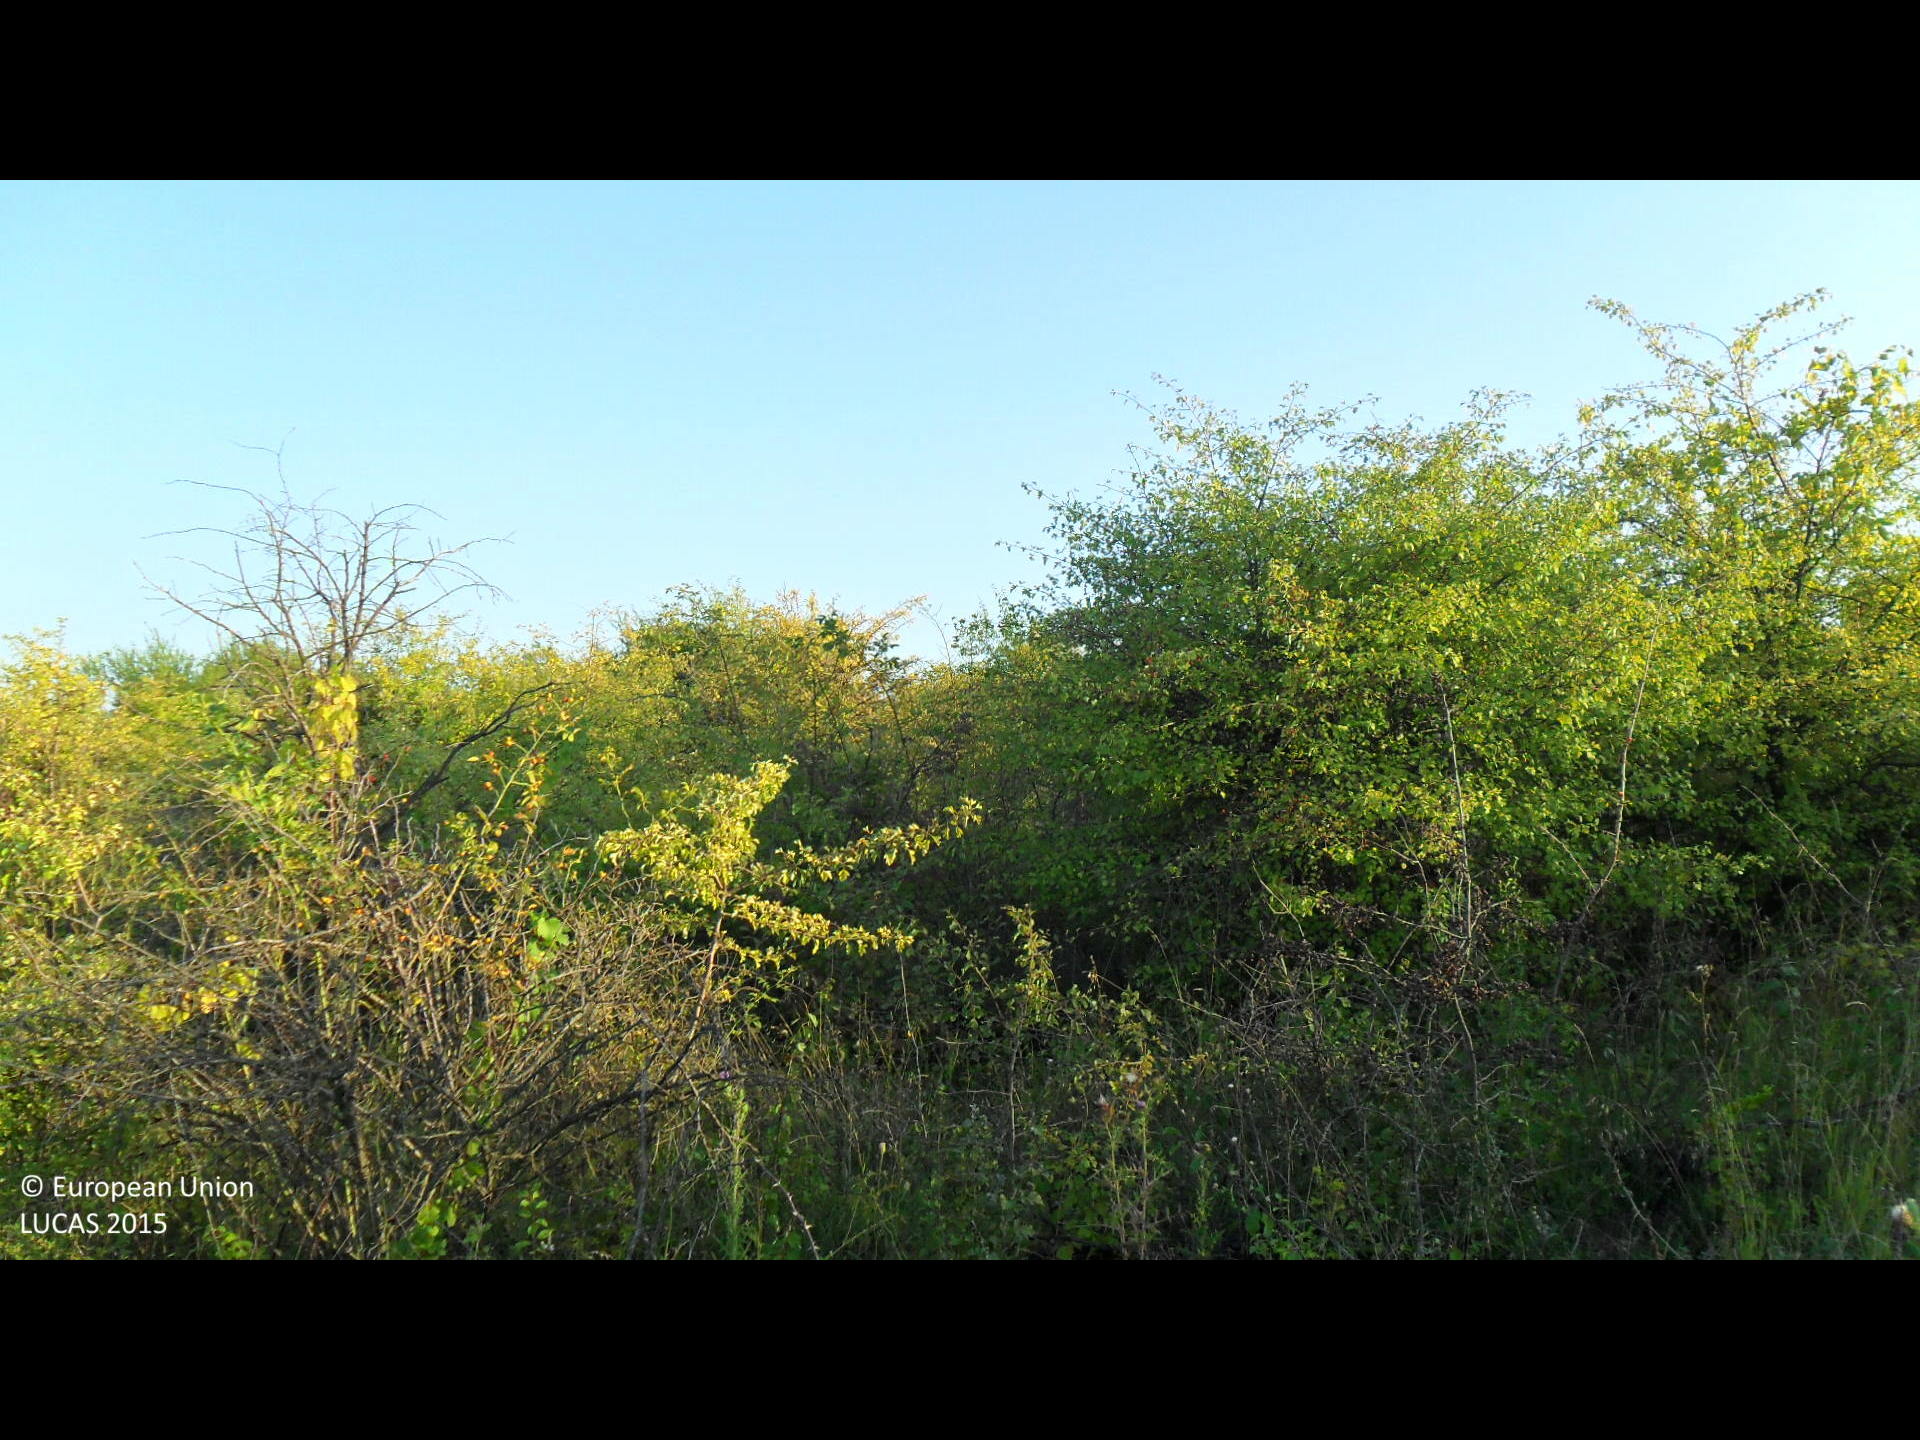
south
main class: Cropland
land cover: Vineyards
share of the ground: 50 - 75 %
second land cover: Spontaneously vegetated surfaces
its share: 25 - 50 %
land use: Abandoned areas
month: August
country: BG
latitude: 43.2031
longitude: 26.6079
